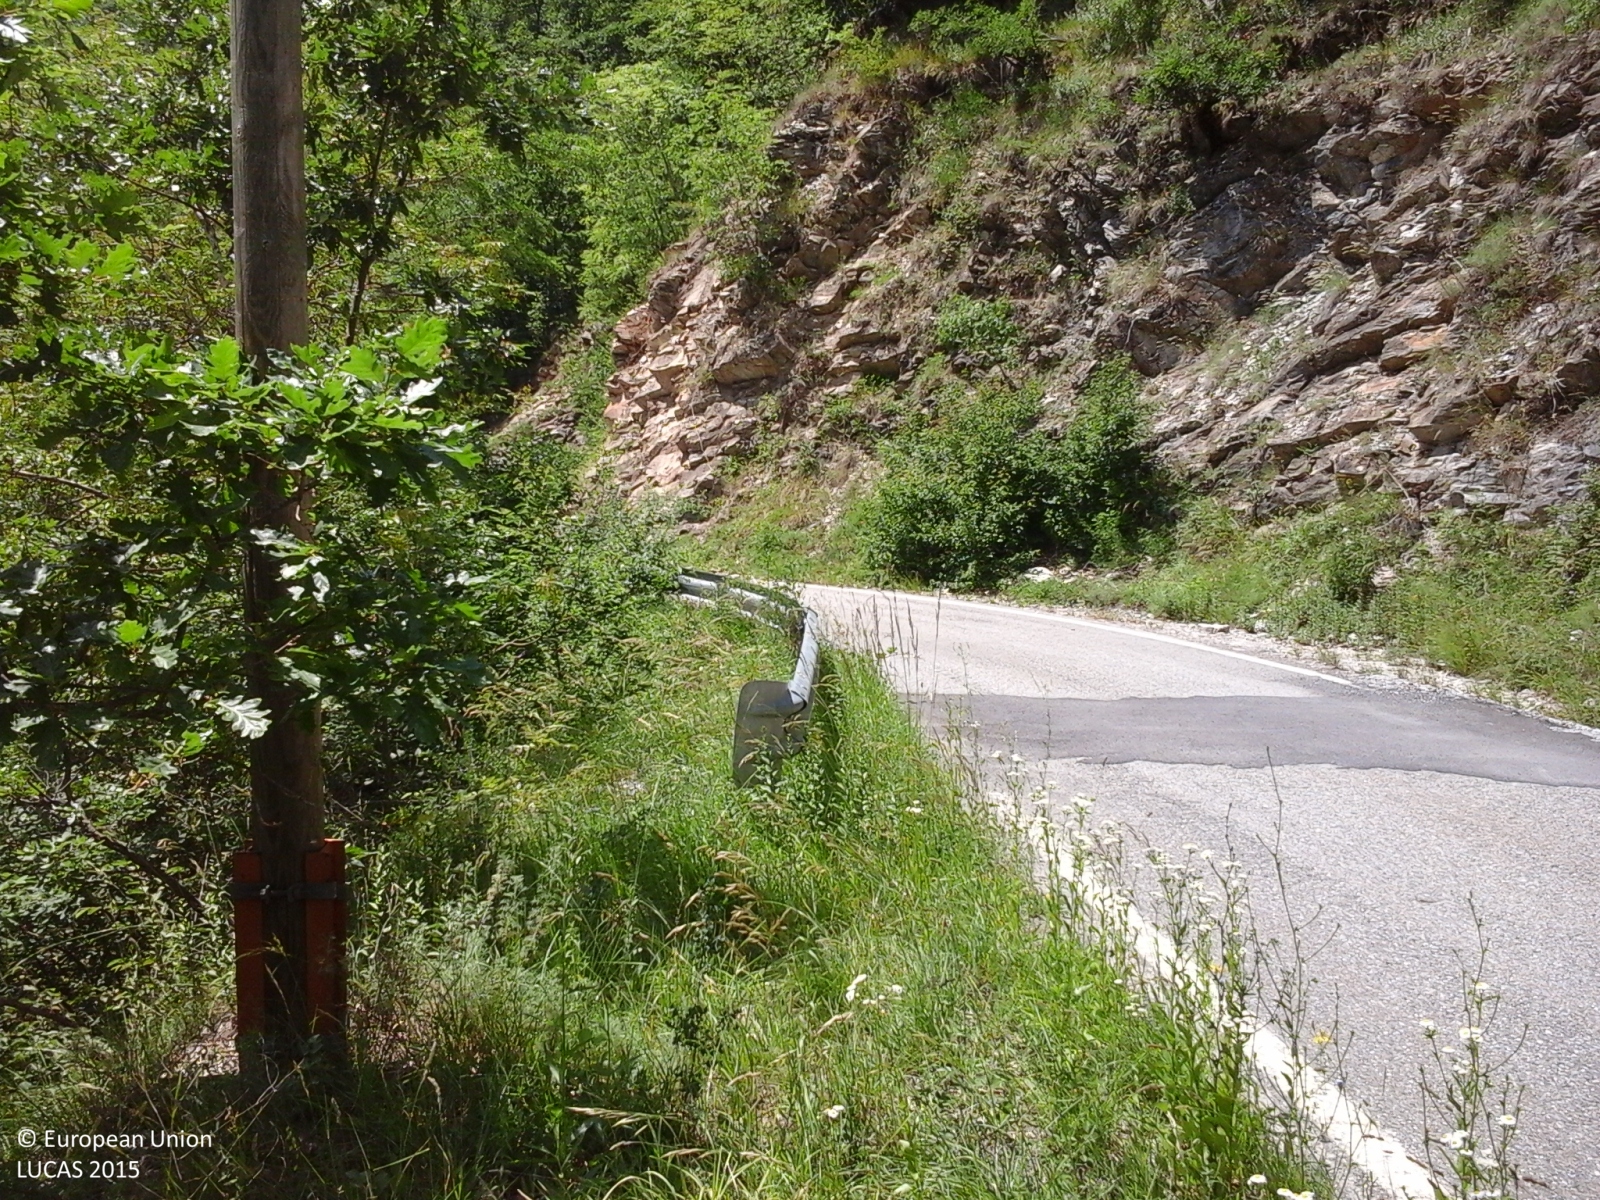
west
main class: Woodland
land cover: Broadleaved woodland
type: thermophilous deciduous forest
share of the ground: > 75 %
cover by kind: broadleaved forest trees 90 %, shrubs 5 %, herbaceous plants 5 %
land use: Forestry
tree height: > 5 m
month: June
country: IT
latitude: 44.6357
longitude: 9.1572
